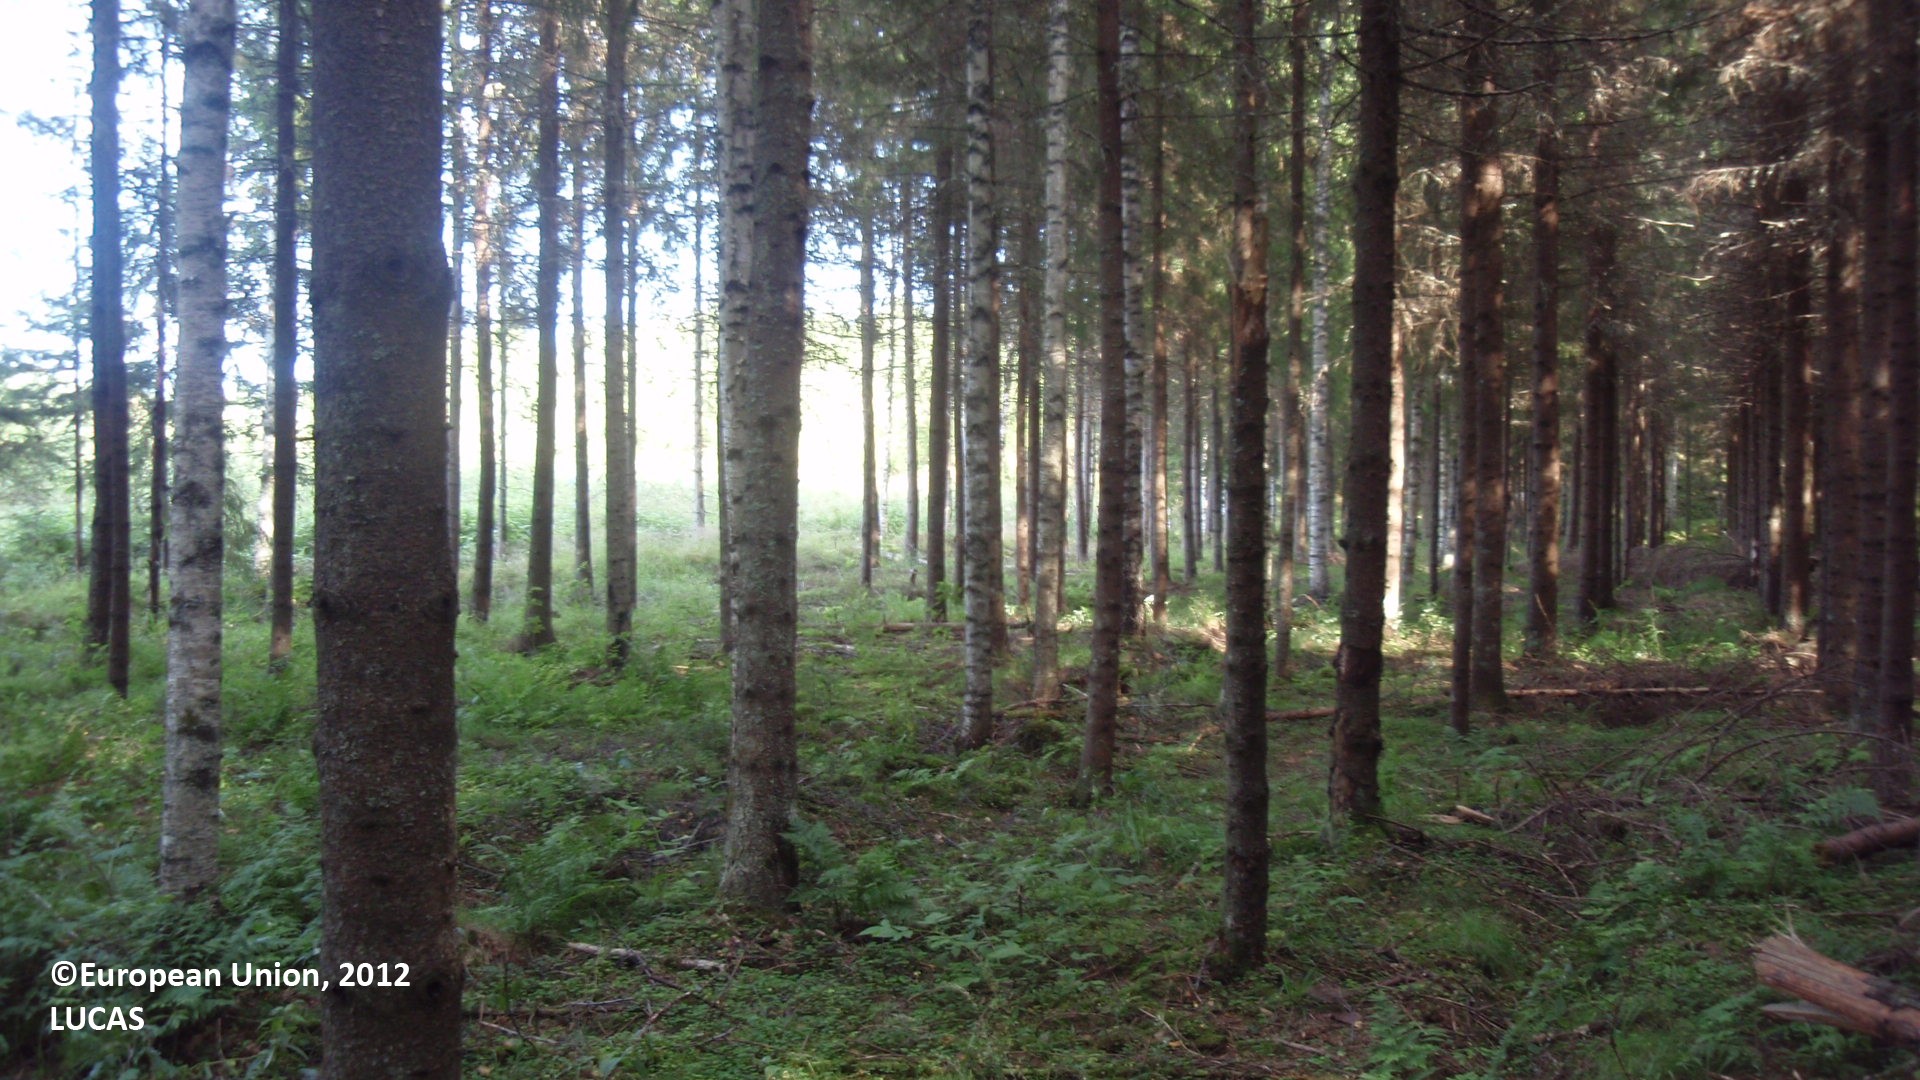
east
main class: Woodland
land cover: Spruce dominated coniferous woodland
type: boreal forest
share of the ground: 50 - 75 %
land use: Forestry
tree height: > 5 m
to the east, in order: Spruce dominated coniferous woodland; Ditches and canals; Spruce dominated coniferous woodland; Spruce dominated mixed woodland; Pine dominated mixed woodland; Spruce dominated mixed woodland
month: August
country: FI
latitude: 60.7726
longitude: 27.2320
